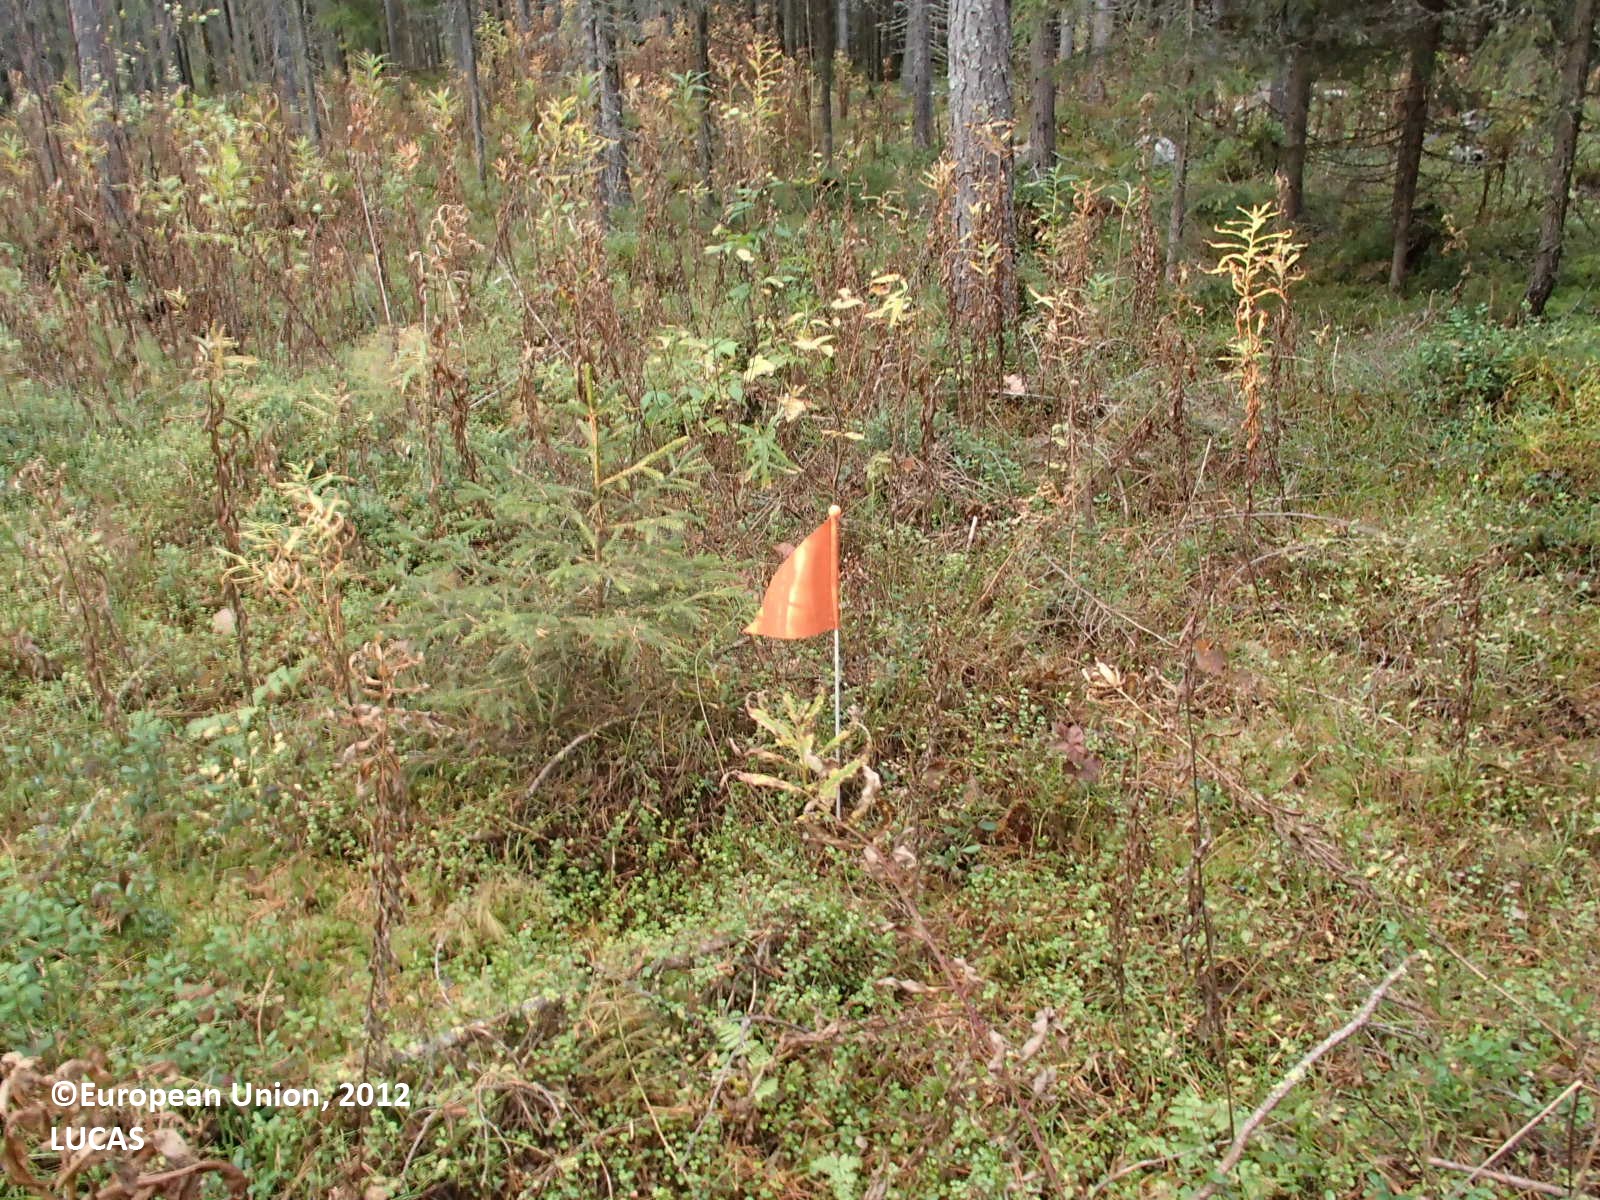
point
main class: Woodland
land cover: Spruce dominated coniferous woodland
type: boreal forest
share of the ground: > 75 %
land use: Forestry
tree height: > 5 m
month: September
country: FI
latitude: 63.5521
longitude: 26.0735
